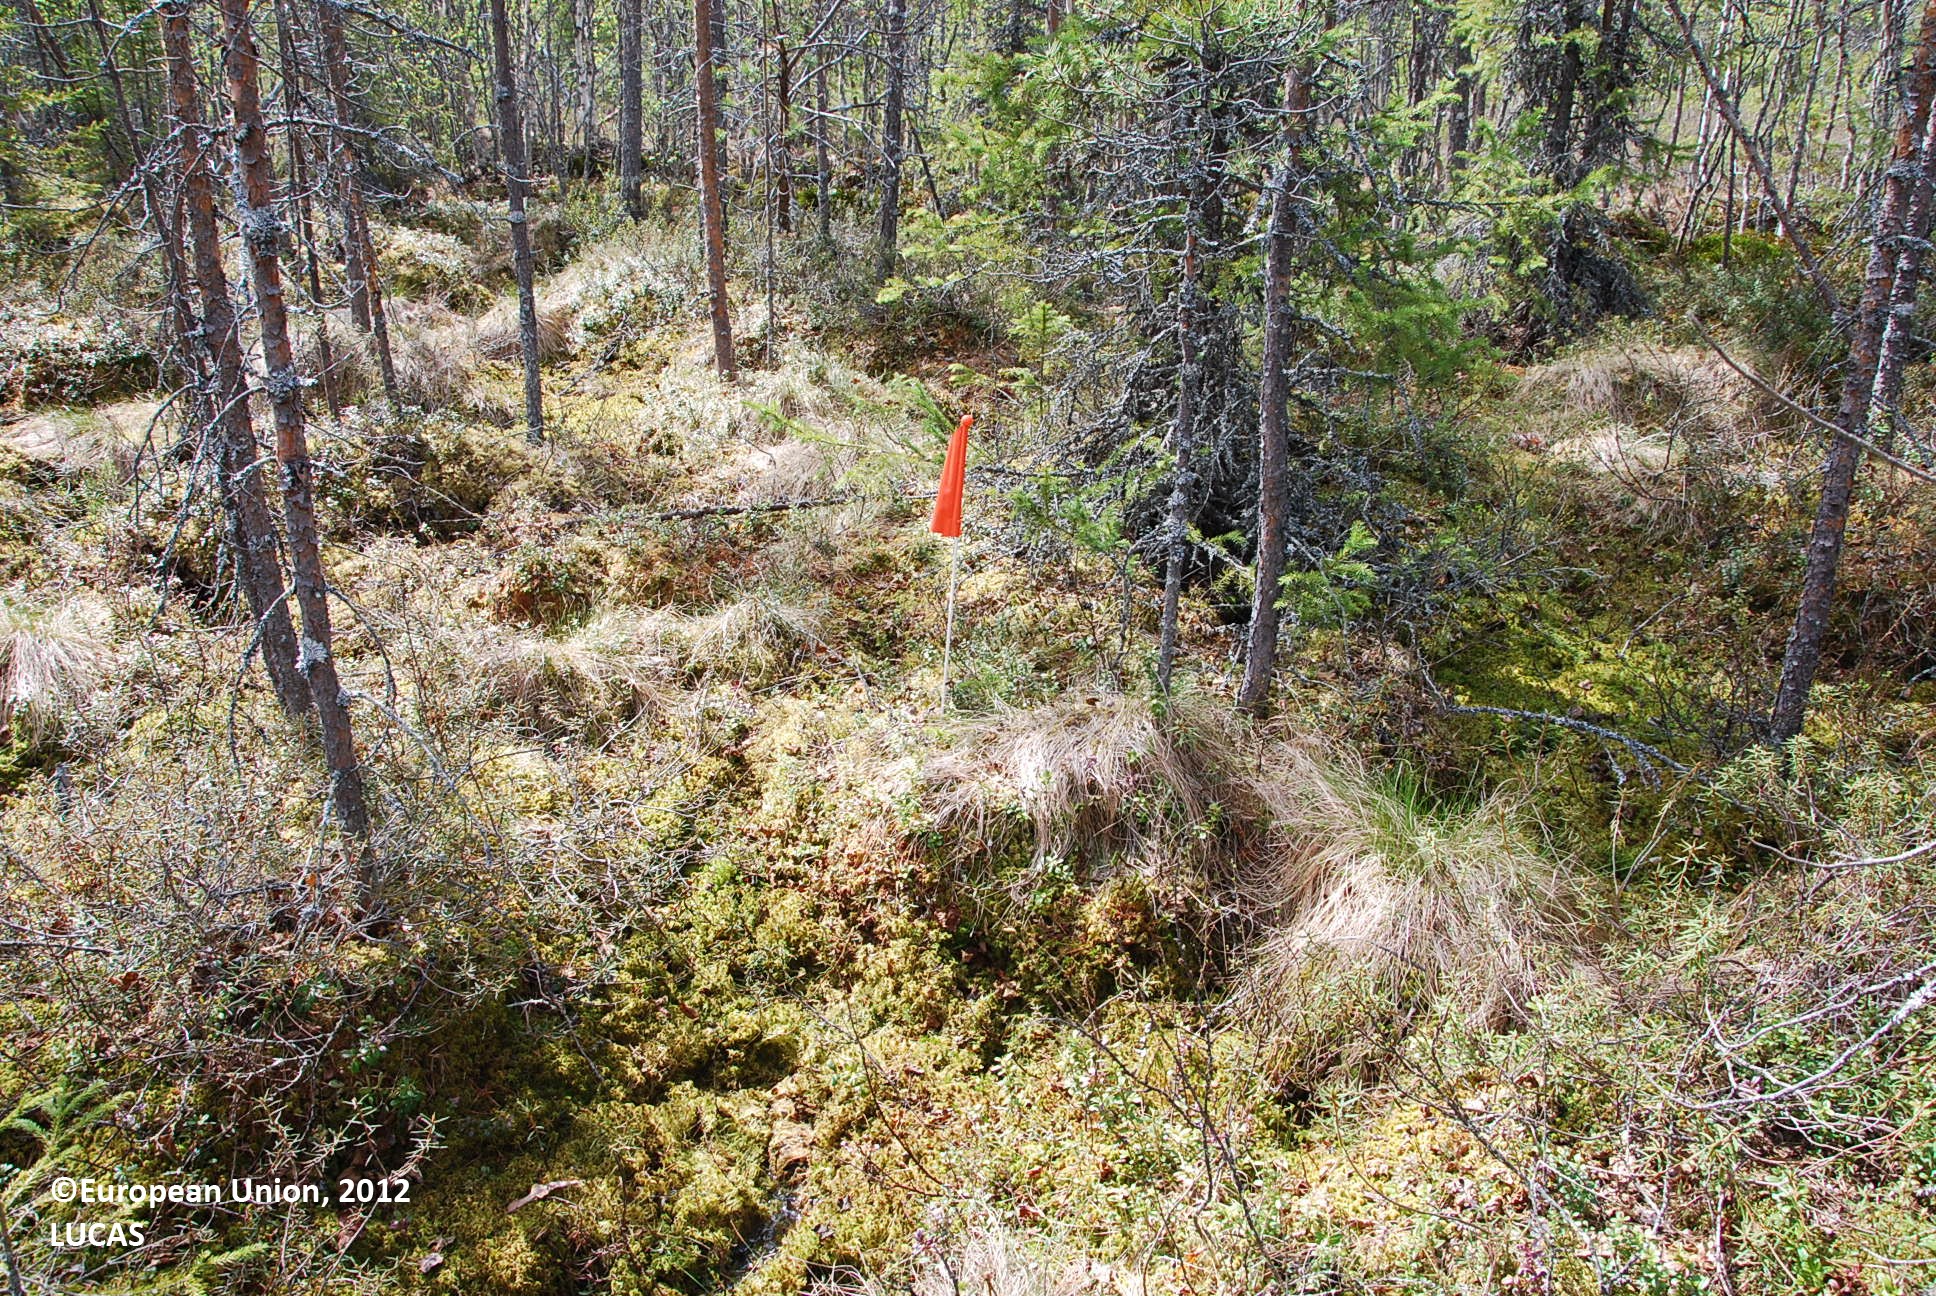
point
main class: Woodland
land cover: Pine dominated coniferous woodland
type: boreal forest
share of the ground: > 75 %
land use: Forestry
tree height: > 5 m
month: June
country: FI
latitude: 66.5791
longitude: 28.0536
